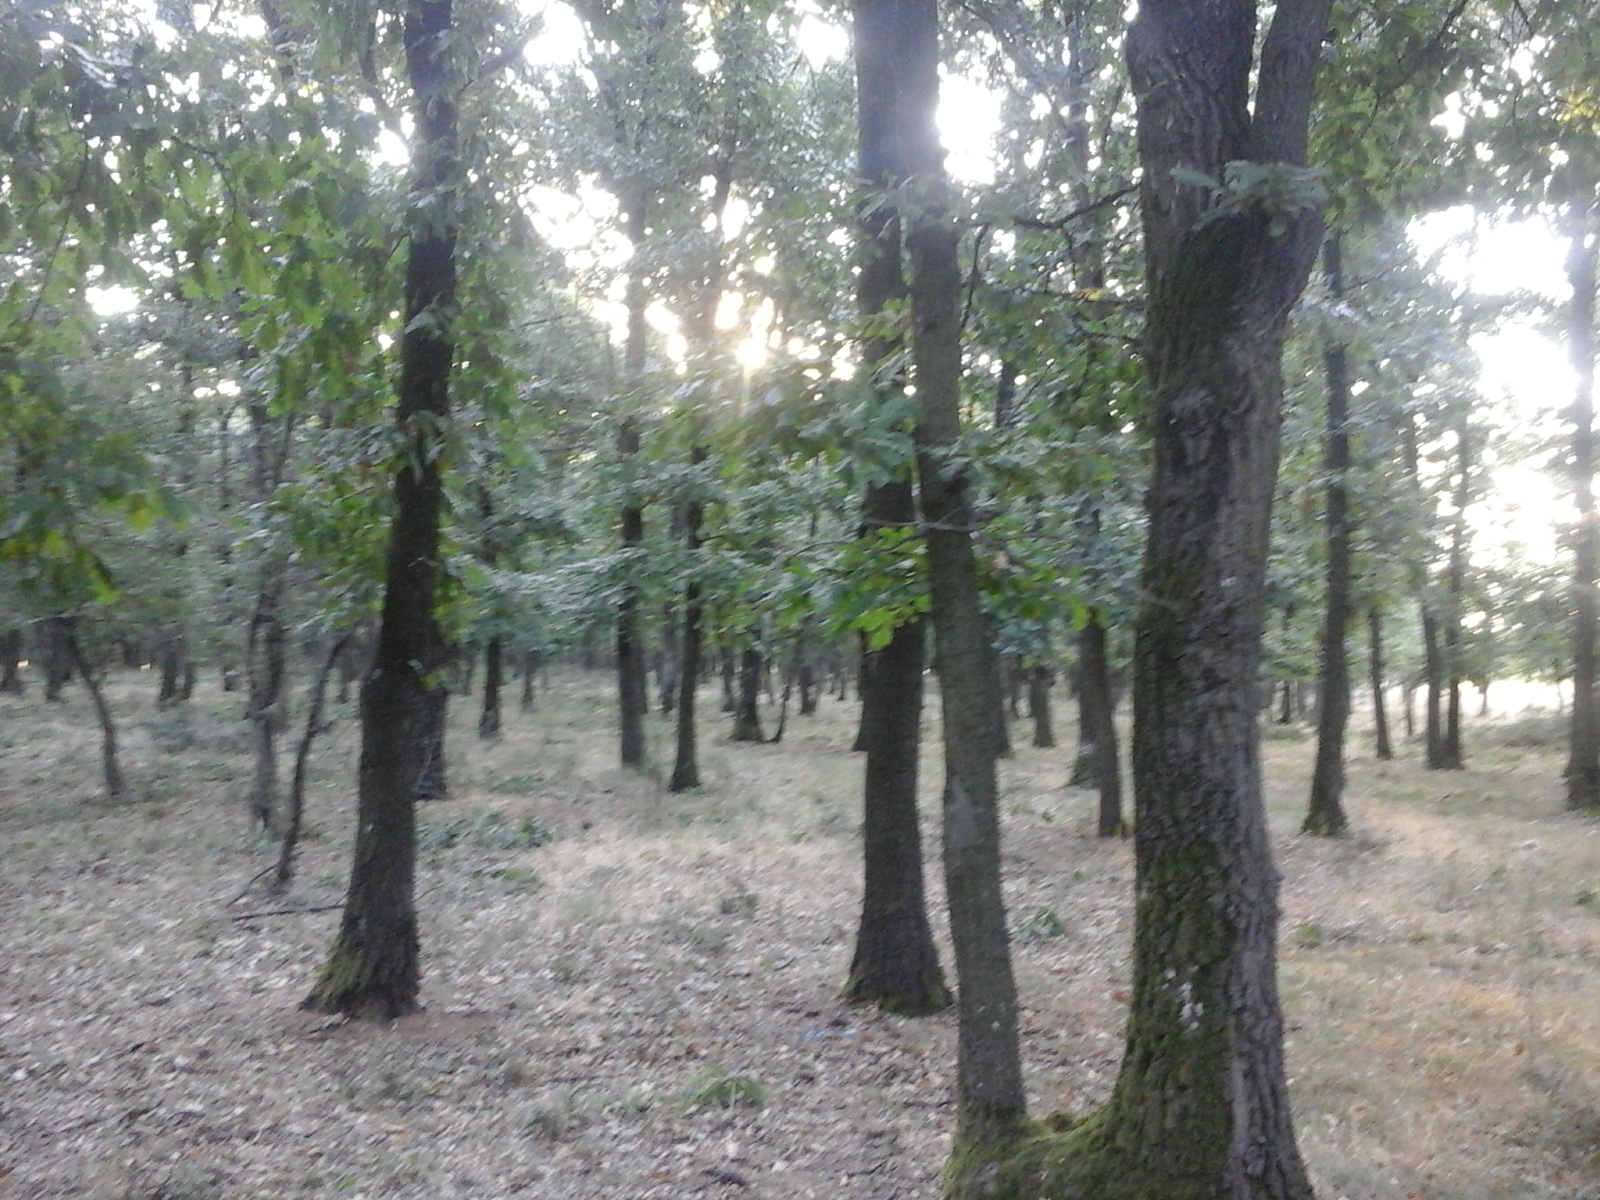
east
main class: Woodland
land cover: Broadleaved woodland
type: acidophilous oak and oak-birch forest
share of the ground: > 75 %
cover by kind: broadleaved forest trees 100 %
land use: Forestry
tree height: > 5 m
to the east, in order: Broadleaved woodland
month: August
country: RO
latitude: 44.1936
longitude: 23.7807
